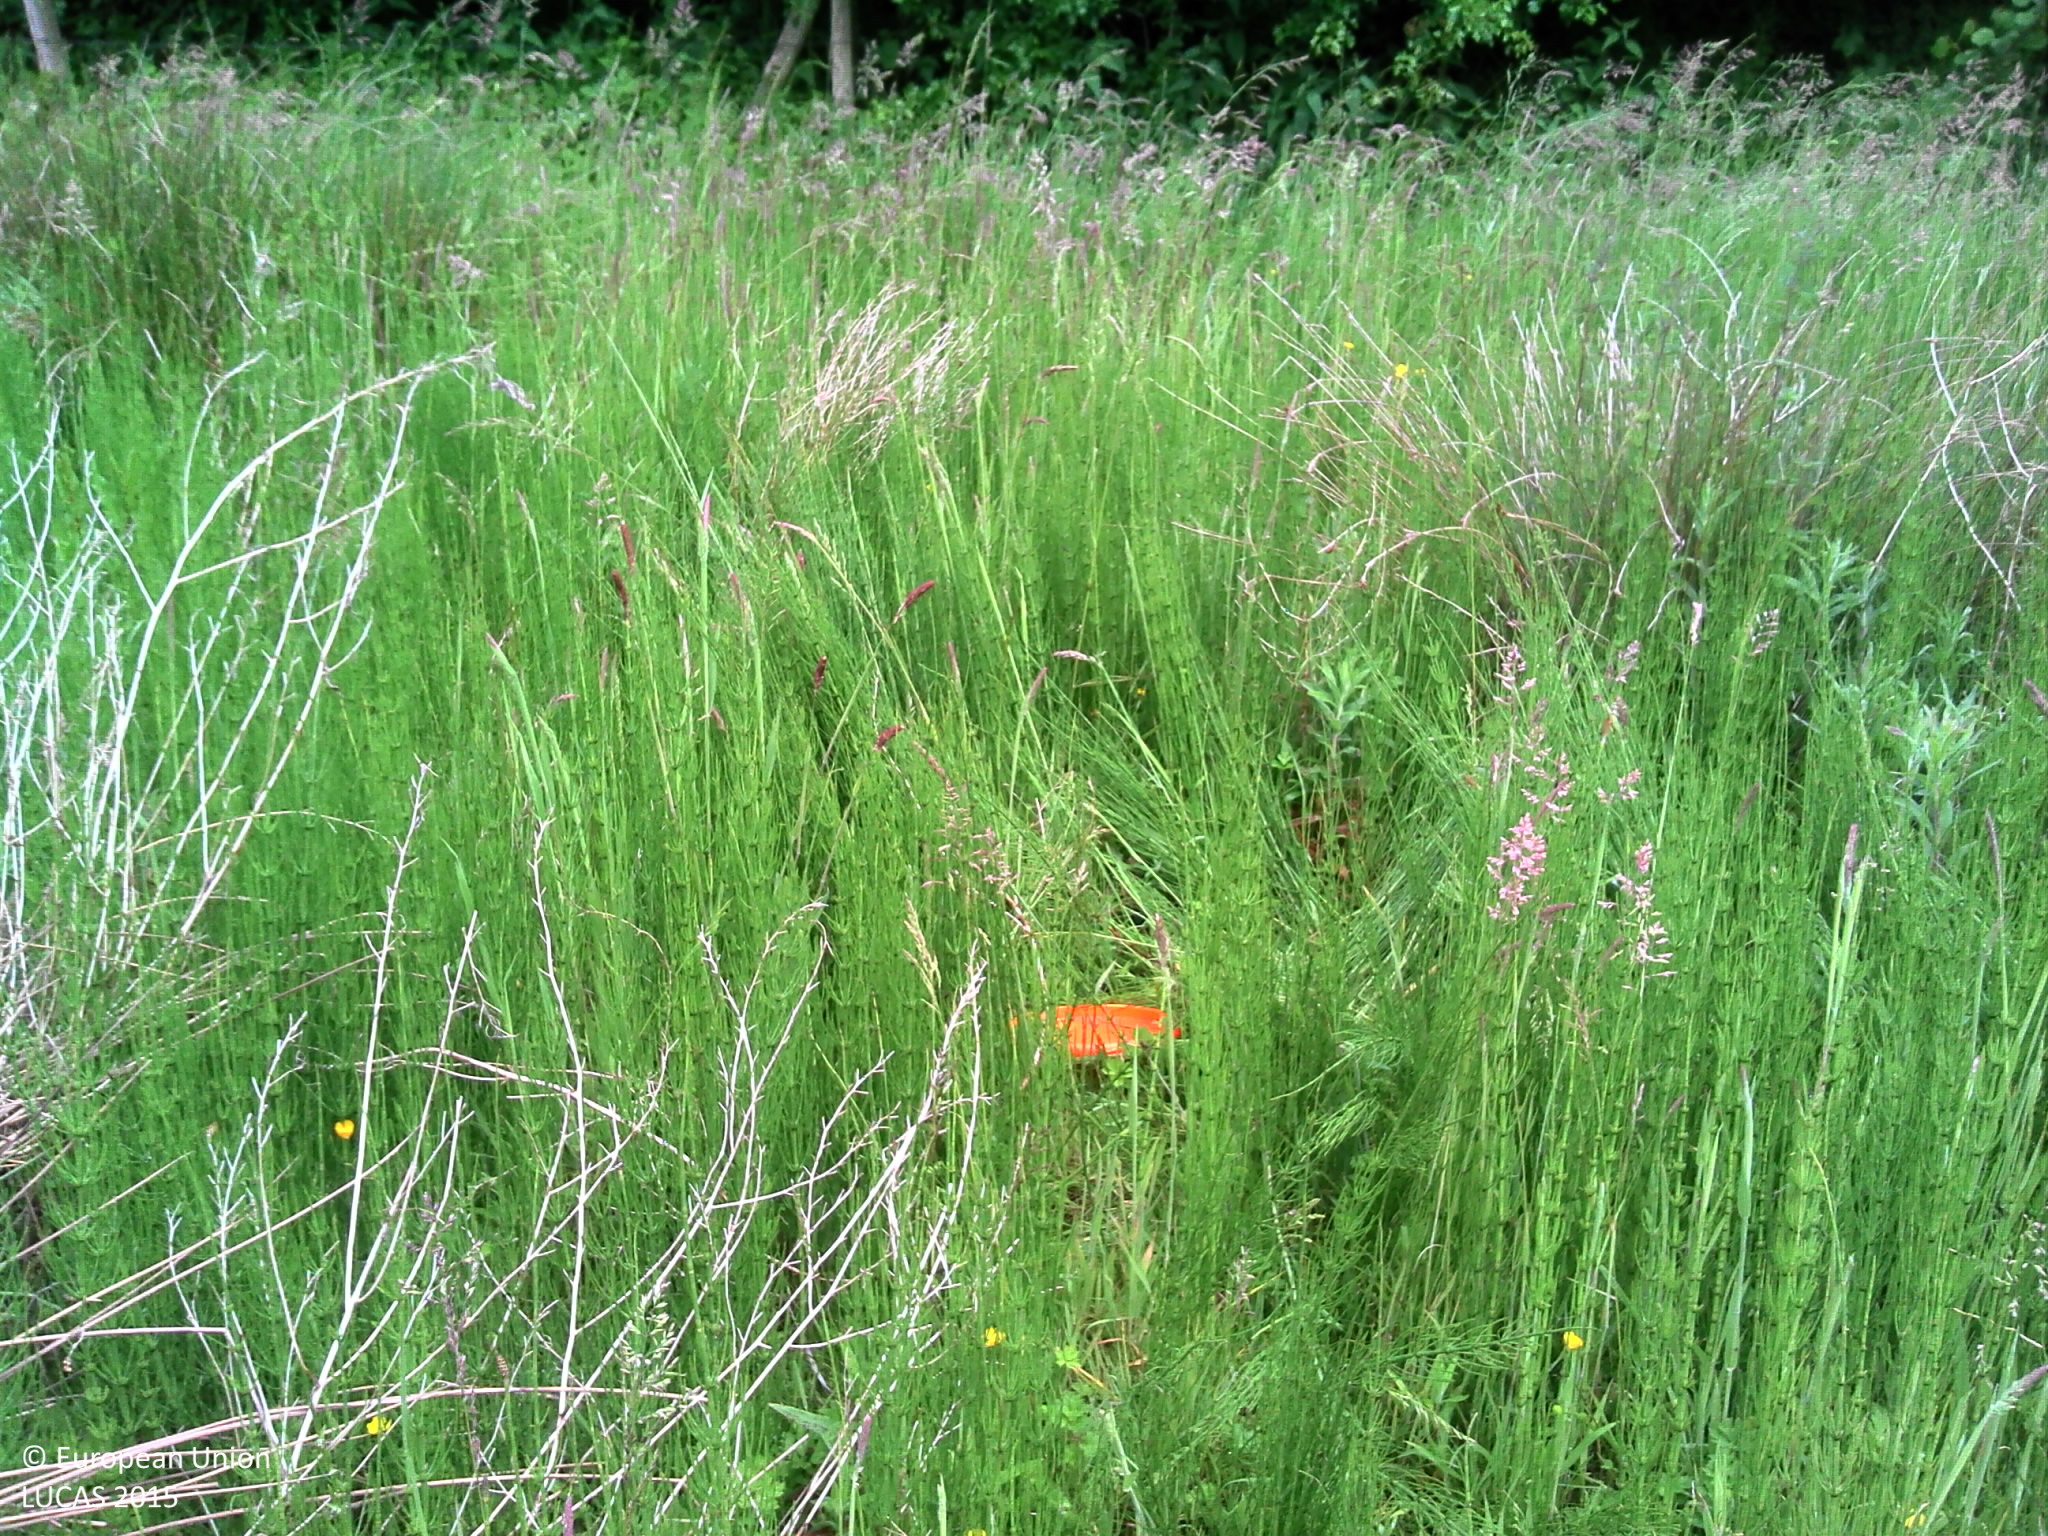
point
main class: Grassland
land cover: Grassland without tree/shrub cover
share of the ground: > 75 %
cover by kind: herbaceous plants 100 %
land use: Agriculture (excluding fallow land and kitchen gardens)
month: June
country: BE
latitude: 50.8041
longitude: 4.0488
